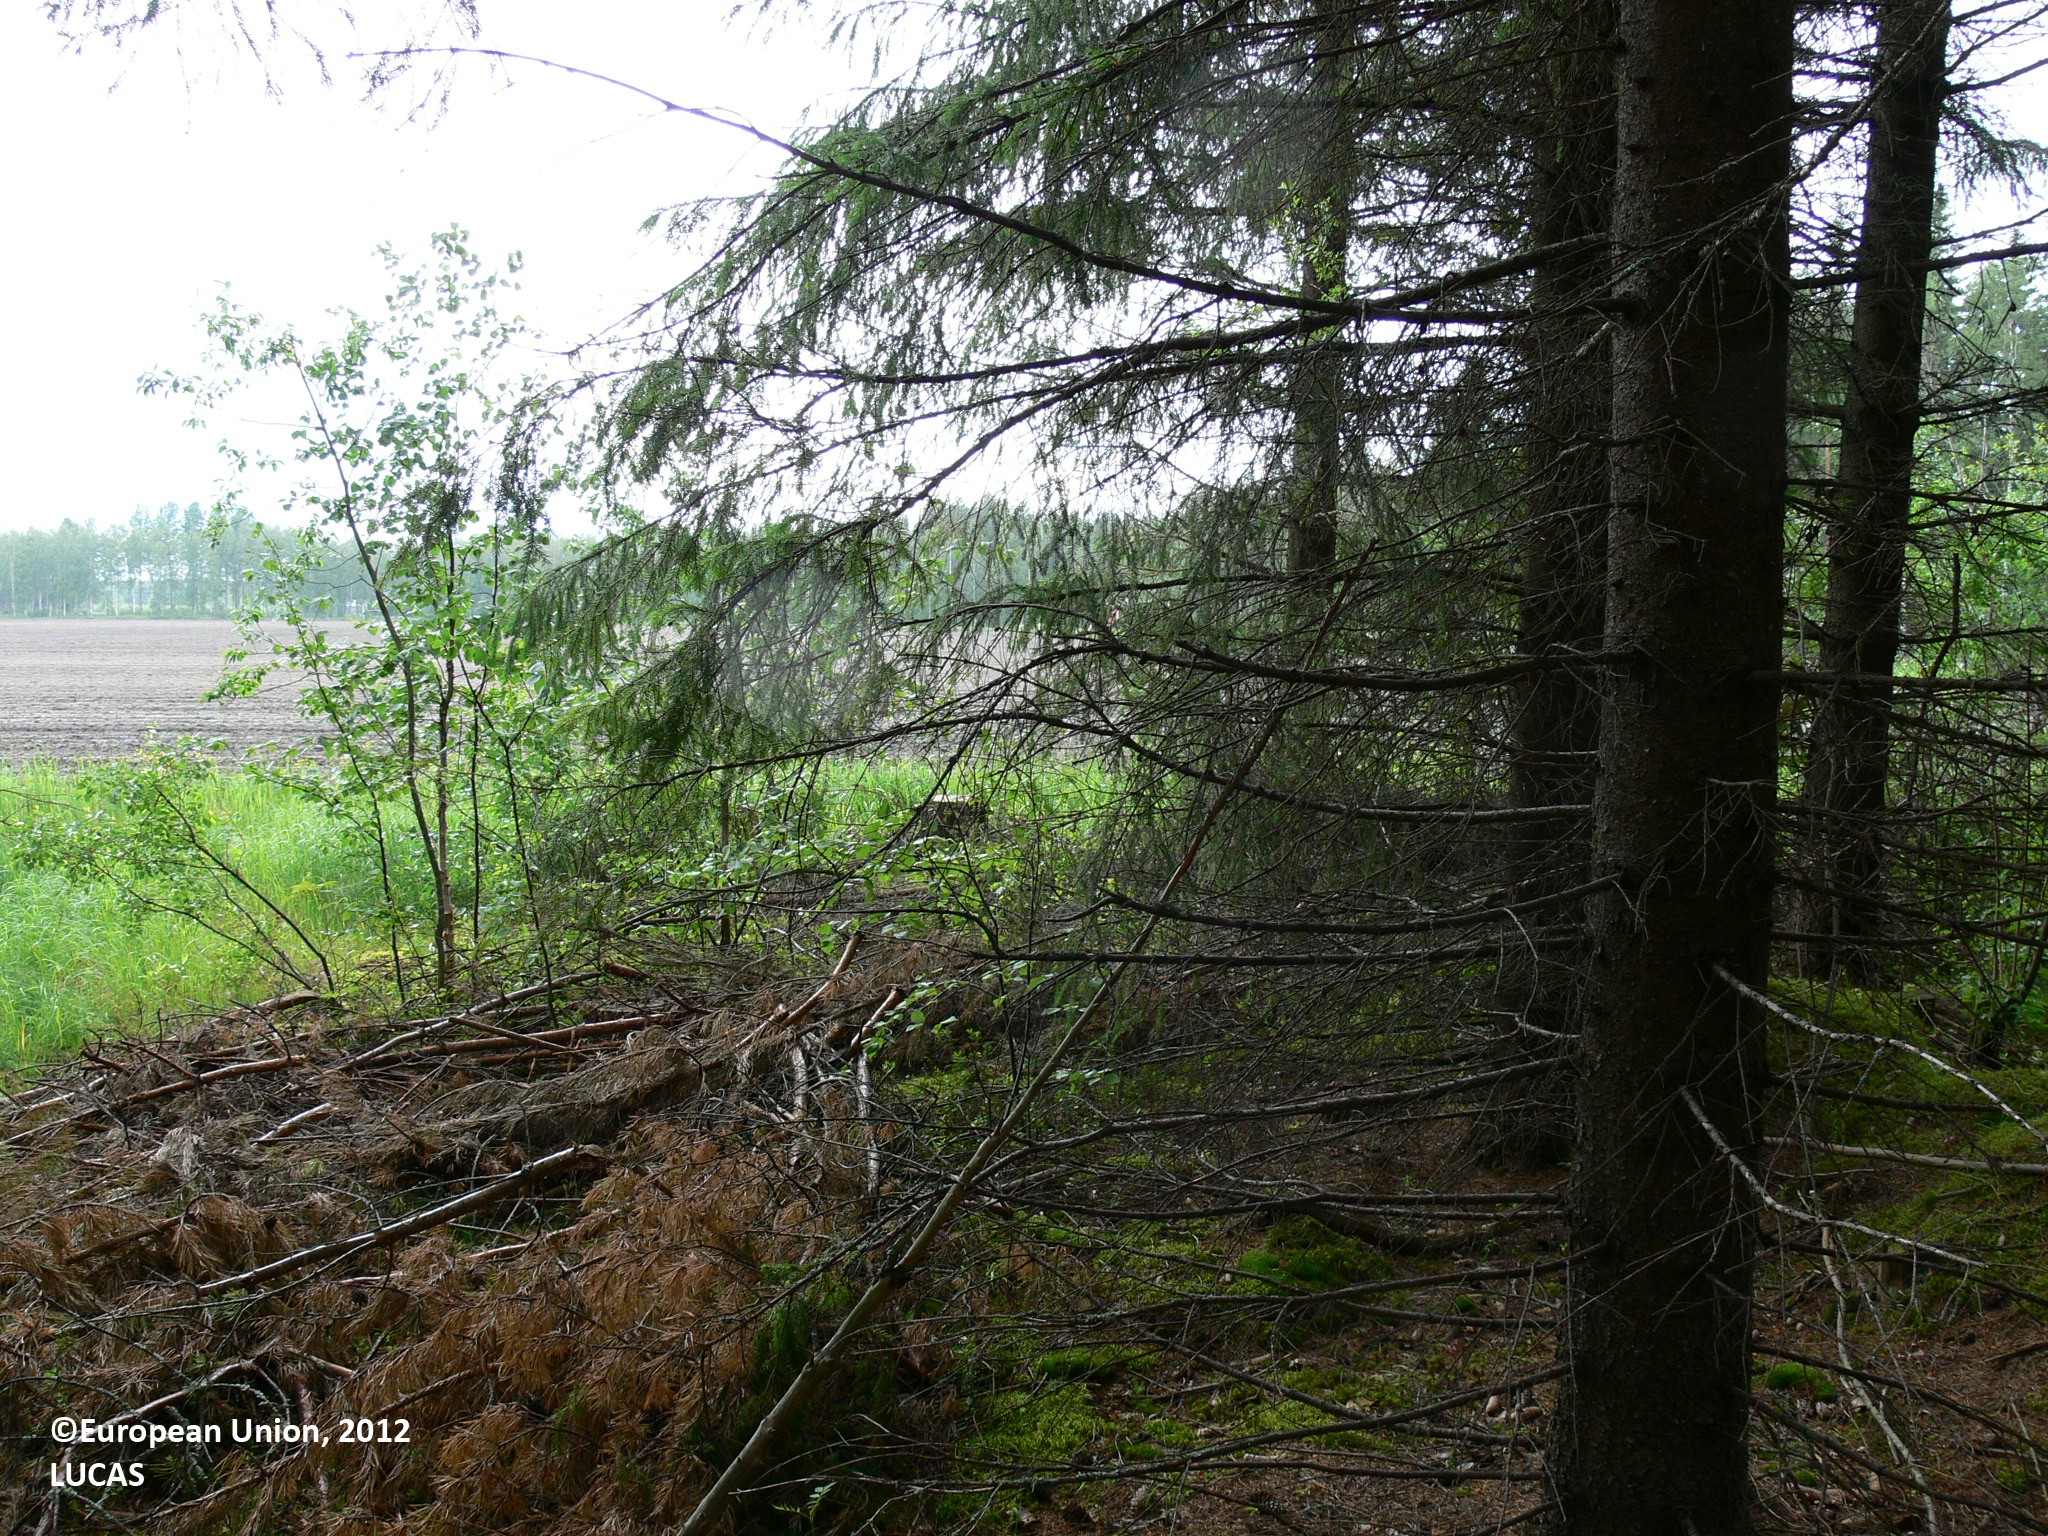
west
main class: Woodland
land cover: Spruce dominated coniferous woodland
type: boreal forest
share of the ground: 50 - 75 %
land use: Forestry
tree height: > 5 m
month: June
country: FI
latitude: 62.5780
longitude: 29.5685
